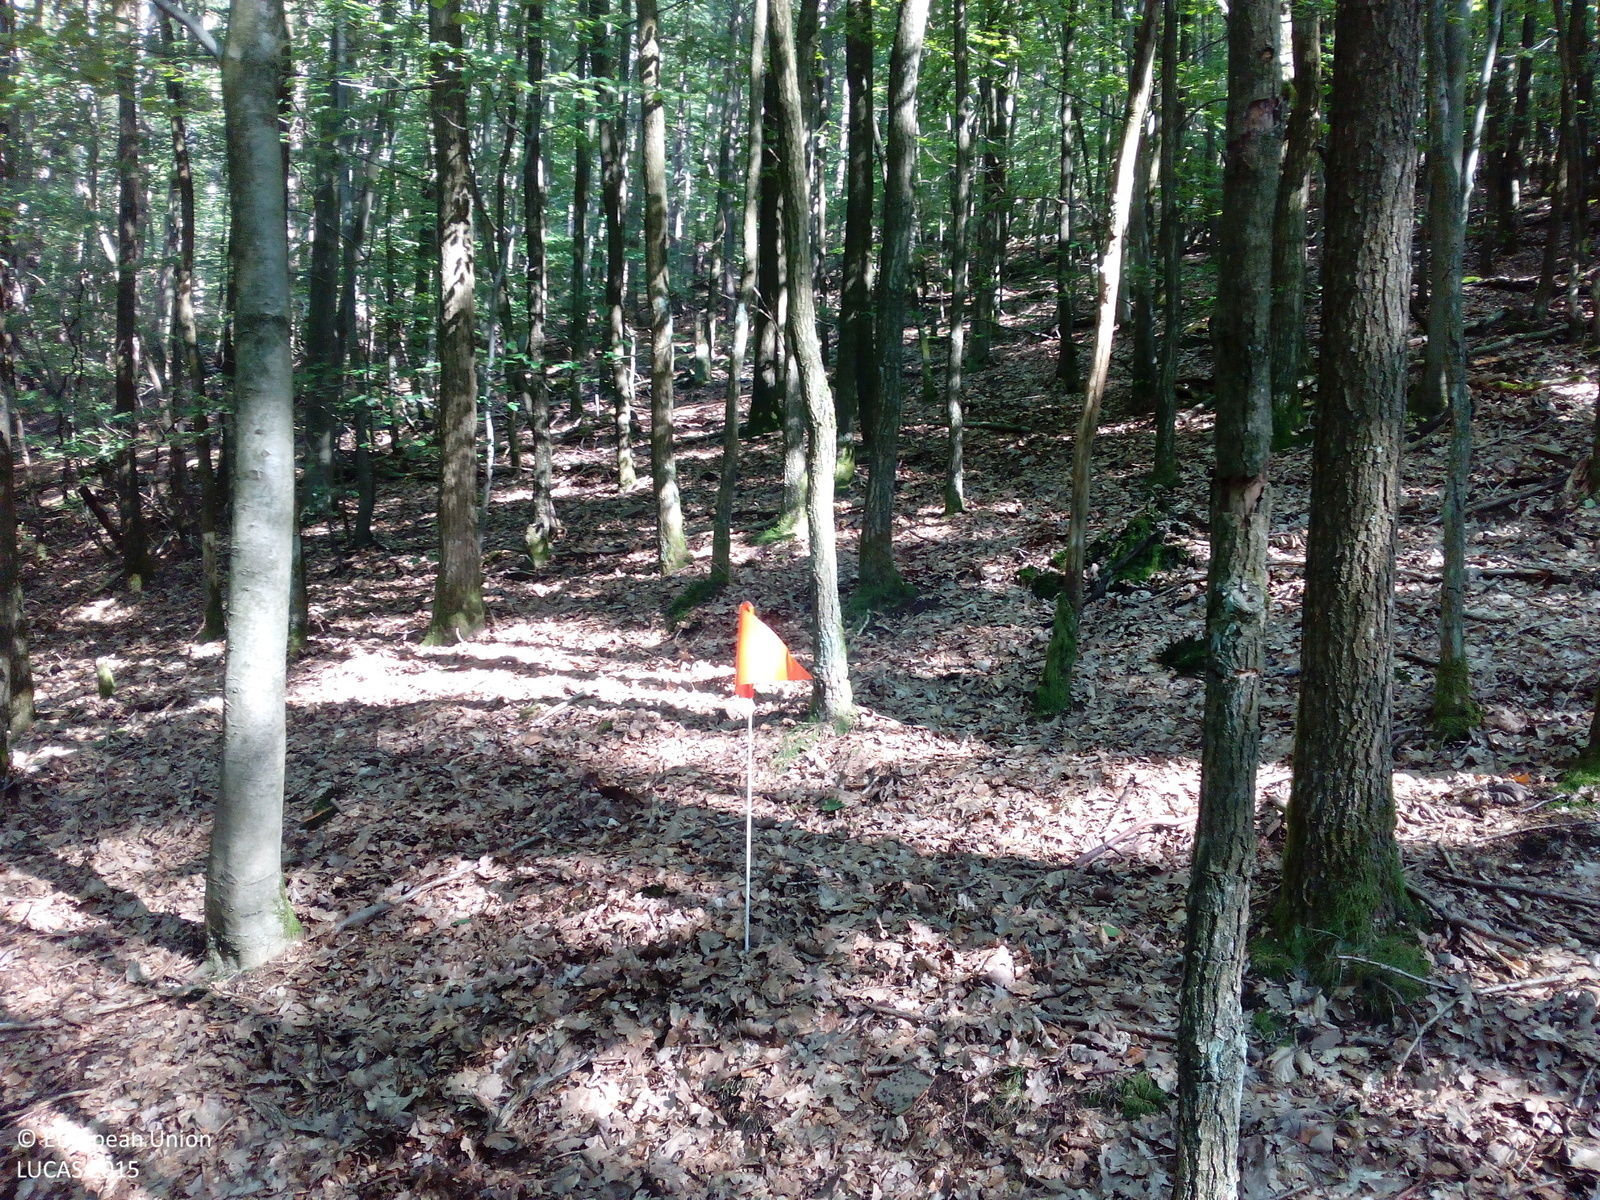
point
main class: Woodland
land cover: Broadleaved woodland
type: acidophilous oak and oak-birch forest
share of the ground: > 75 %
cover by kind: broadleaved forest trees 90 %, unconsolidated bare surface 10 %
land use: Forestry
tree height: > 5 m
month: September
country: DE
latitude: 49.8410
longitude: 9.4023
